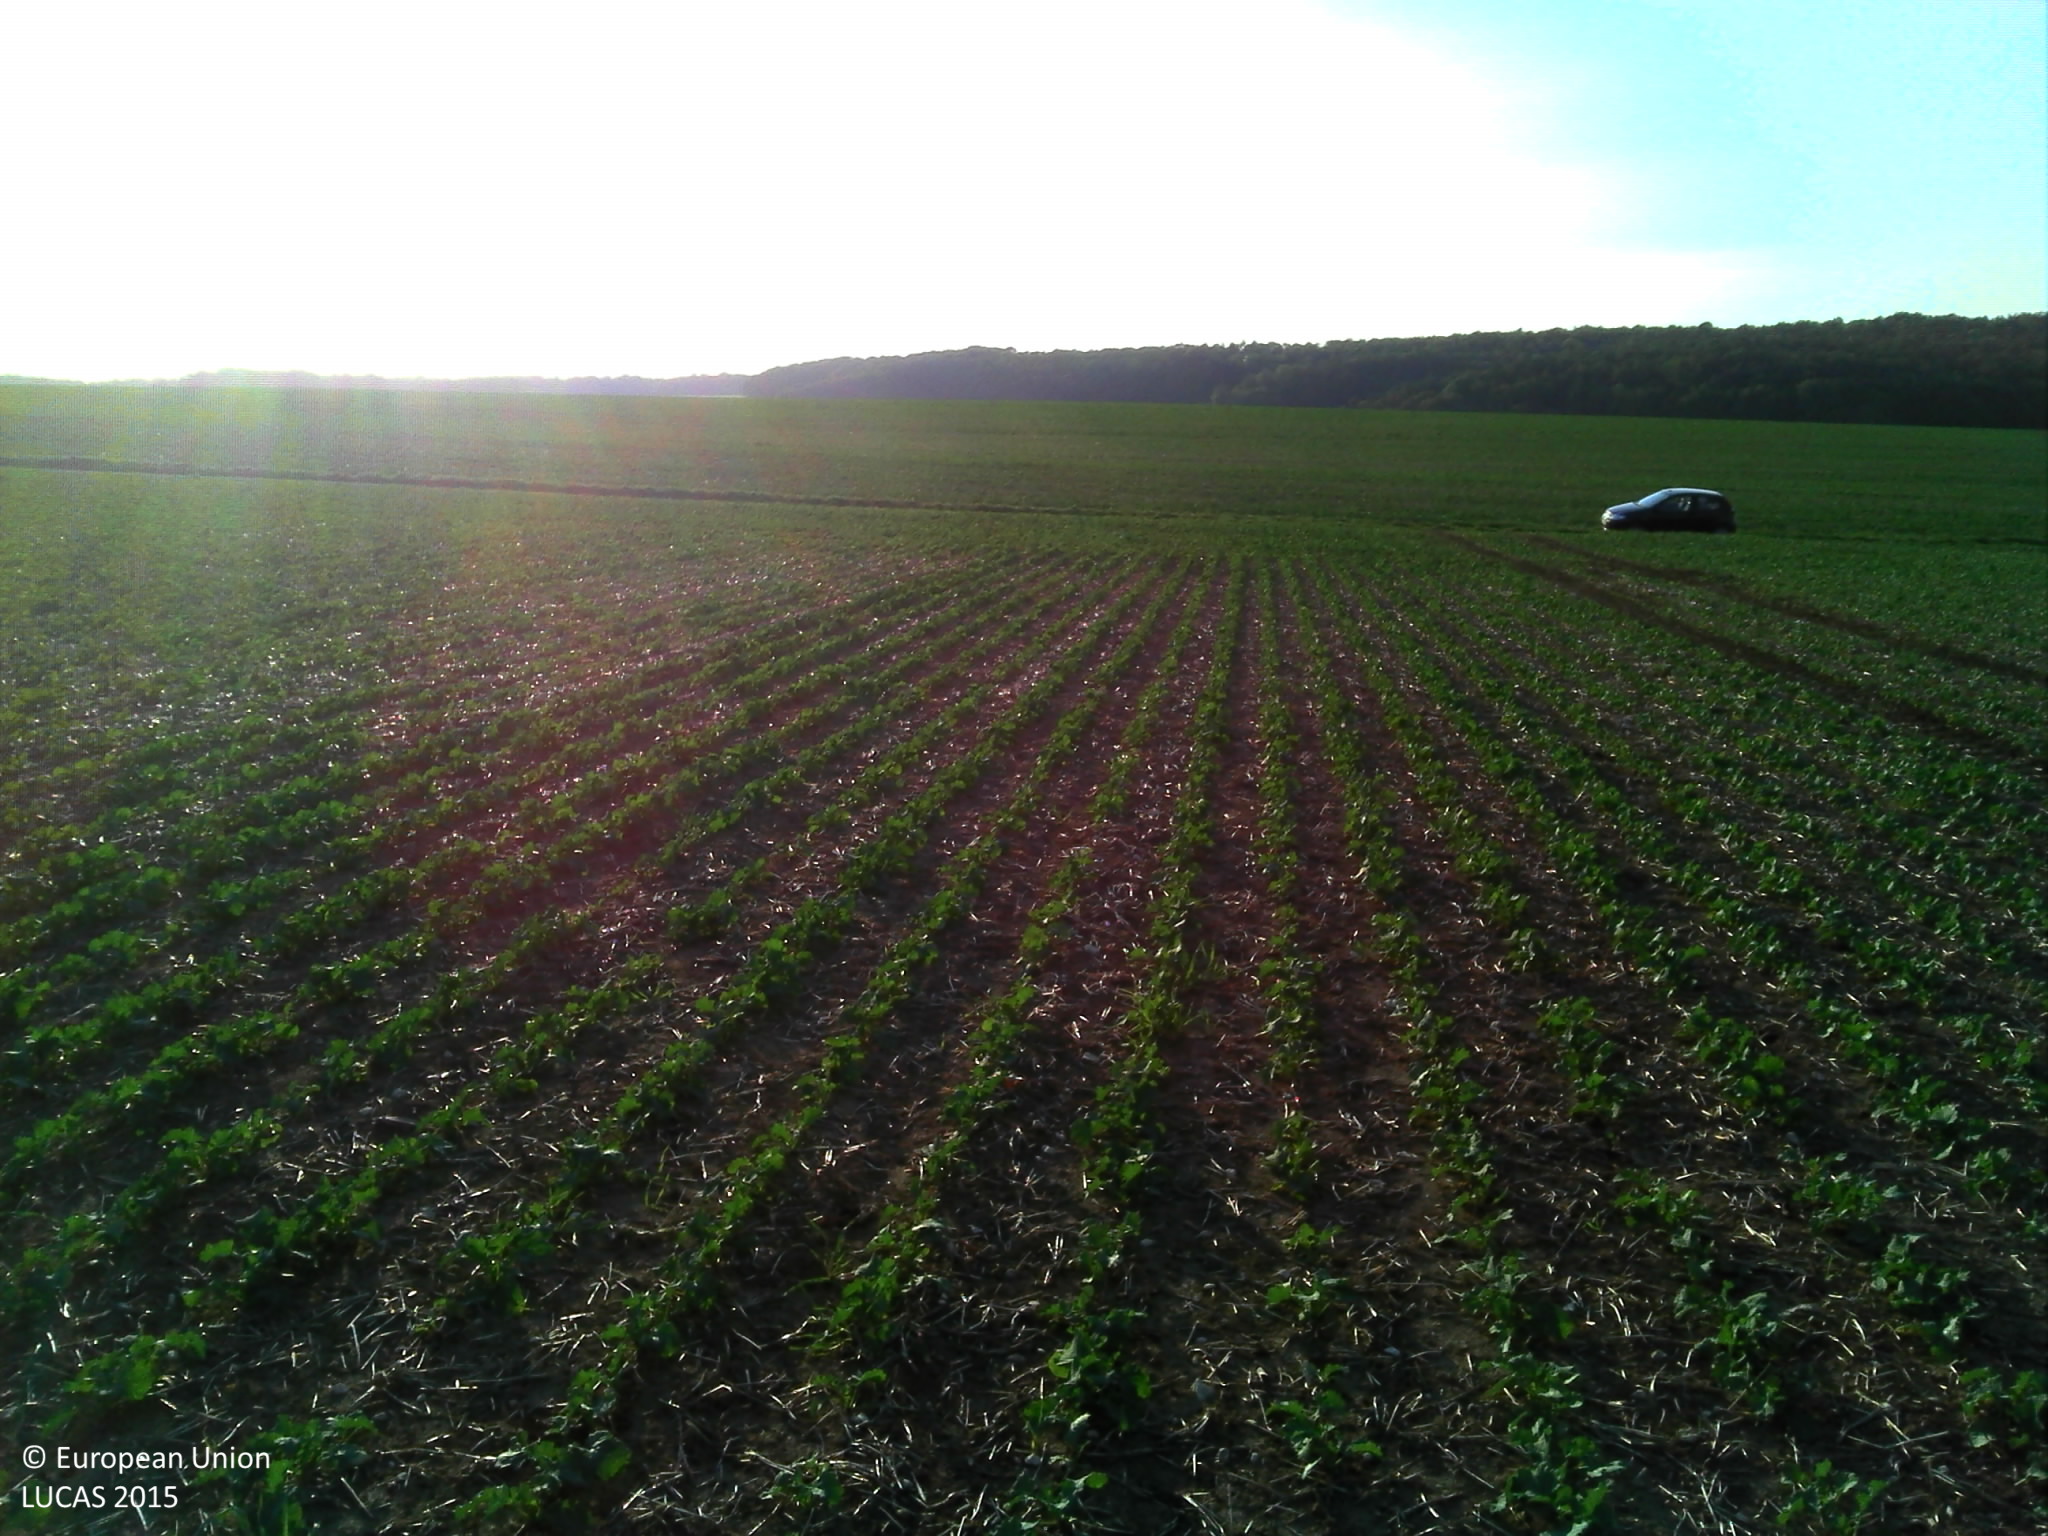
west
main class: Cropland
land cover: Rape and turnip rape
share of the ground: 25 - 50 %
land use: Agriculture (excluding fallow land and kitchen gardens)
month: October
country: FR
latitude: 48.1116
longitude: 4.2889
